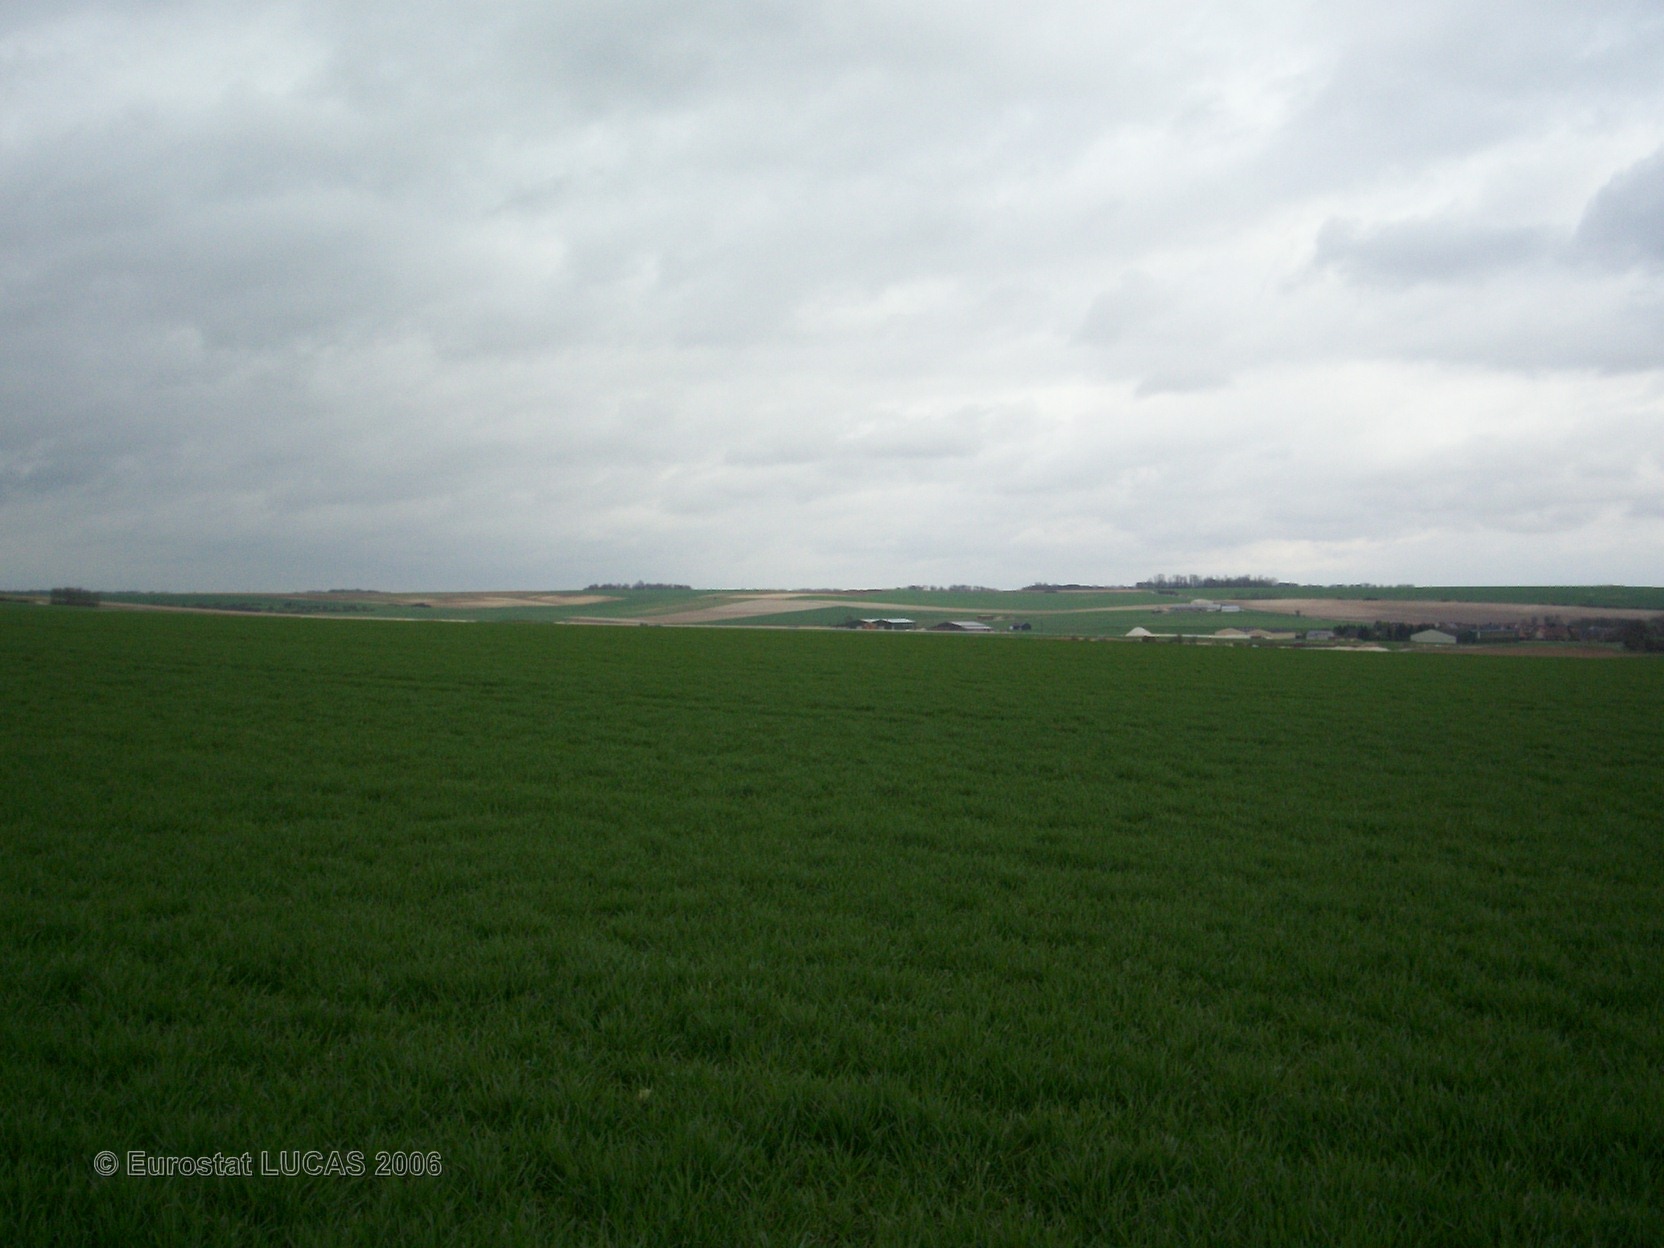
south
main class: Cropland
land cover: Common wheat
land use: Agriculture (excluding fallow land and kitchen gardens)
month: April
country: FR
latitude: 49.9501
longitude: 2.6999
